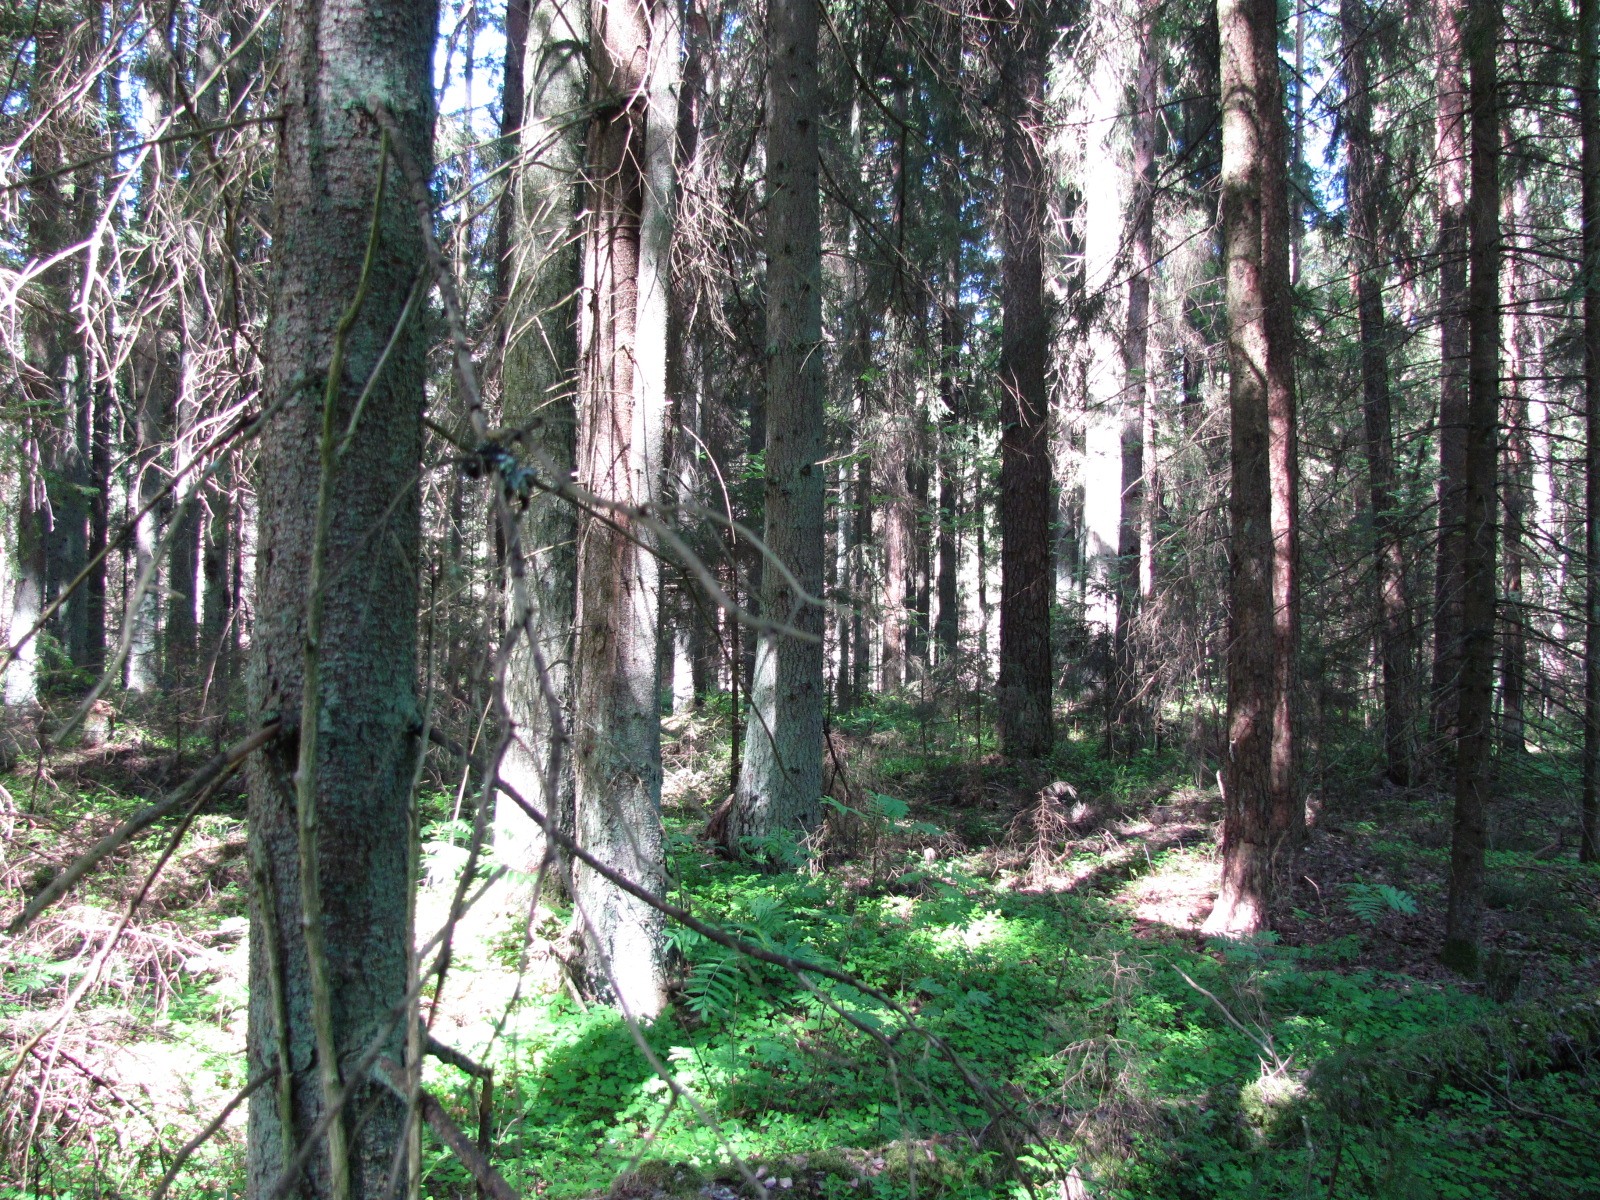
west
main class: Woodland
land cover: Other coniferous woodland
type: hemiboreal forest and nemoral coniferous forest and mixed broadleaved-coniferous forest
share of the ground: > 75 %
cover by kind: coniferous forest trees 95 %, broadleaved forest trees 5 %
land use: Forestry
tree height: > 5 m
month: May
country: LV
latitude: 56.6830
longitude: 24.1090
